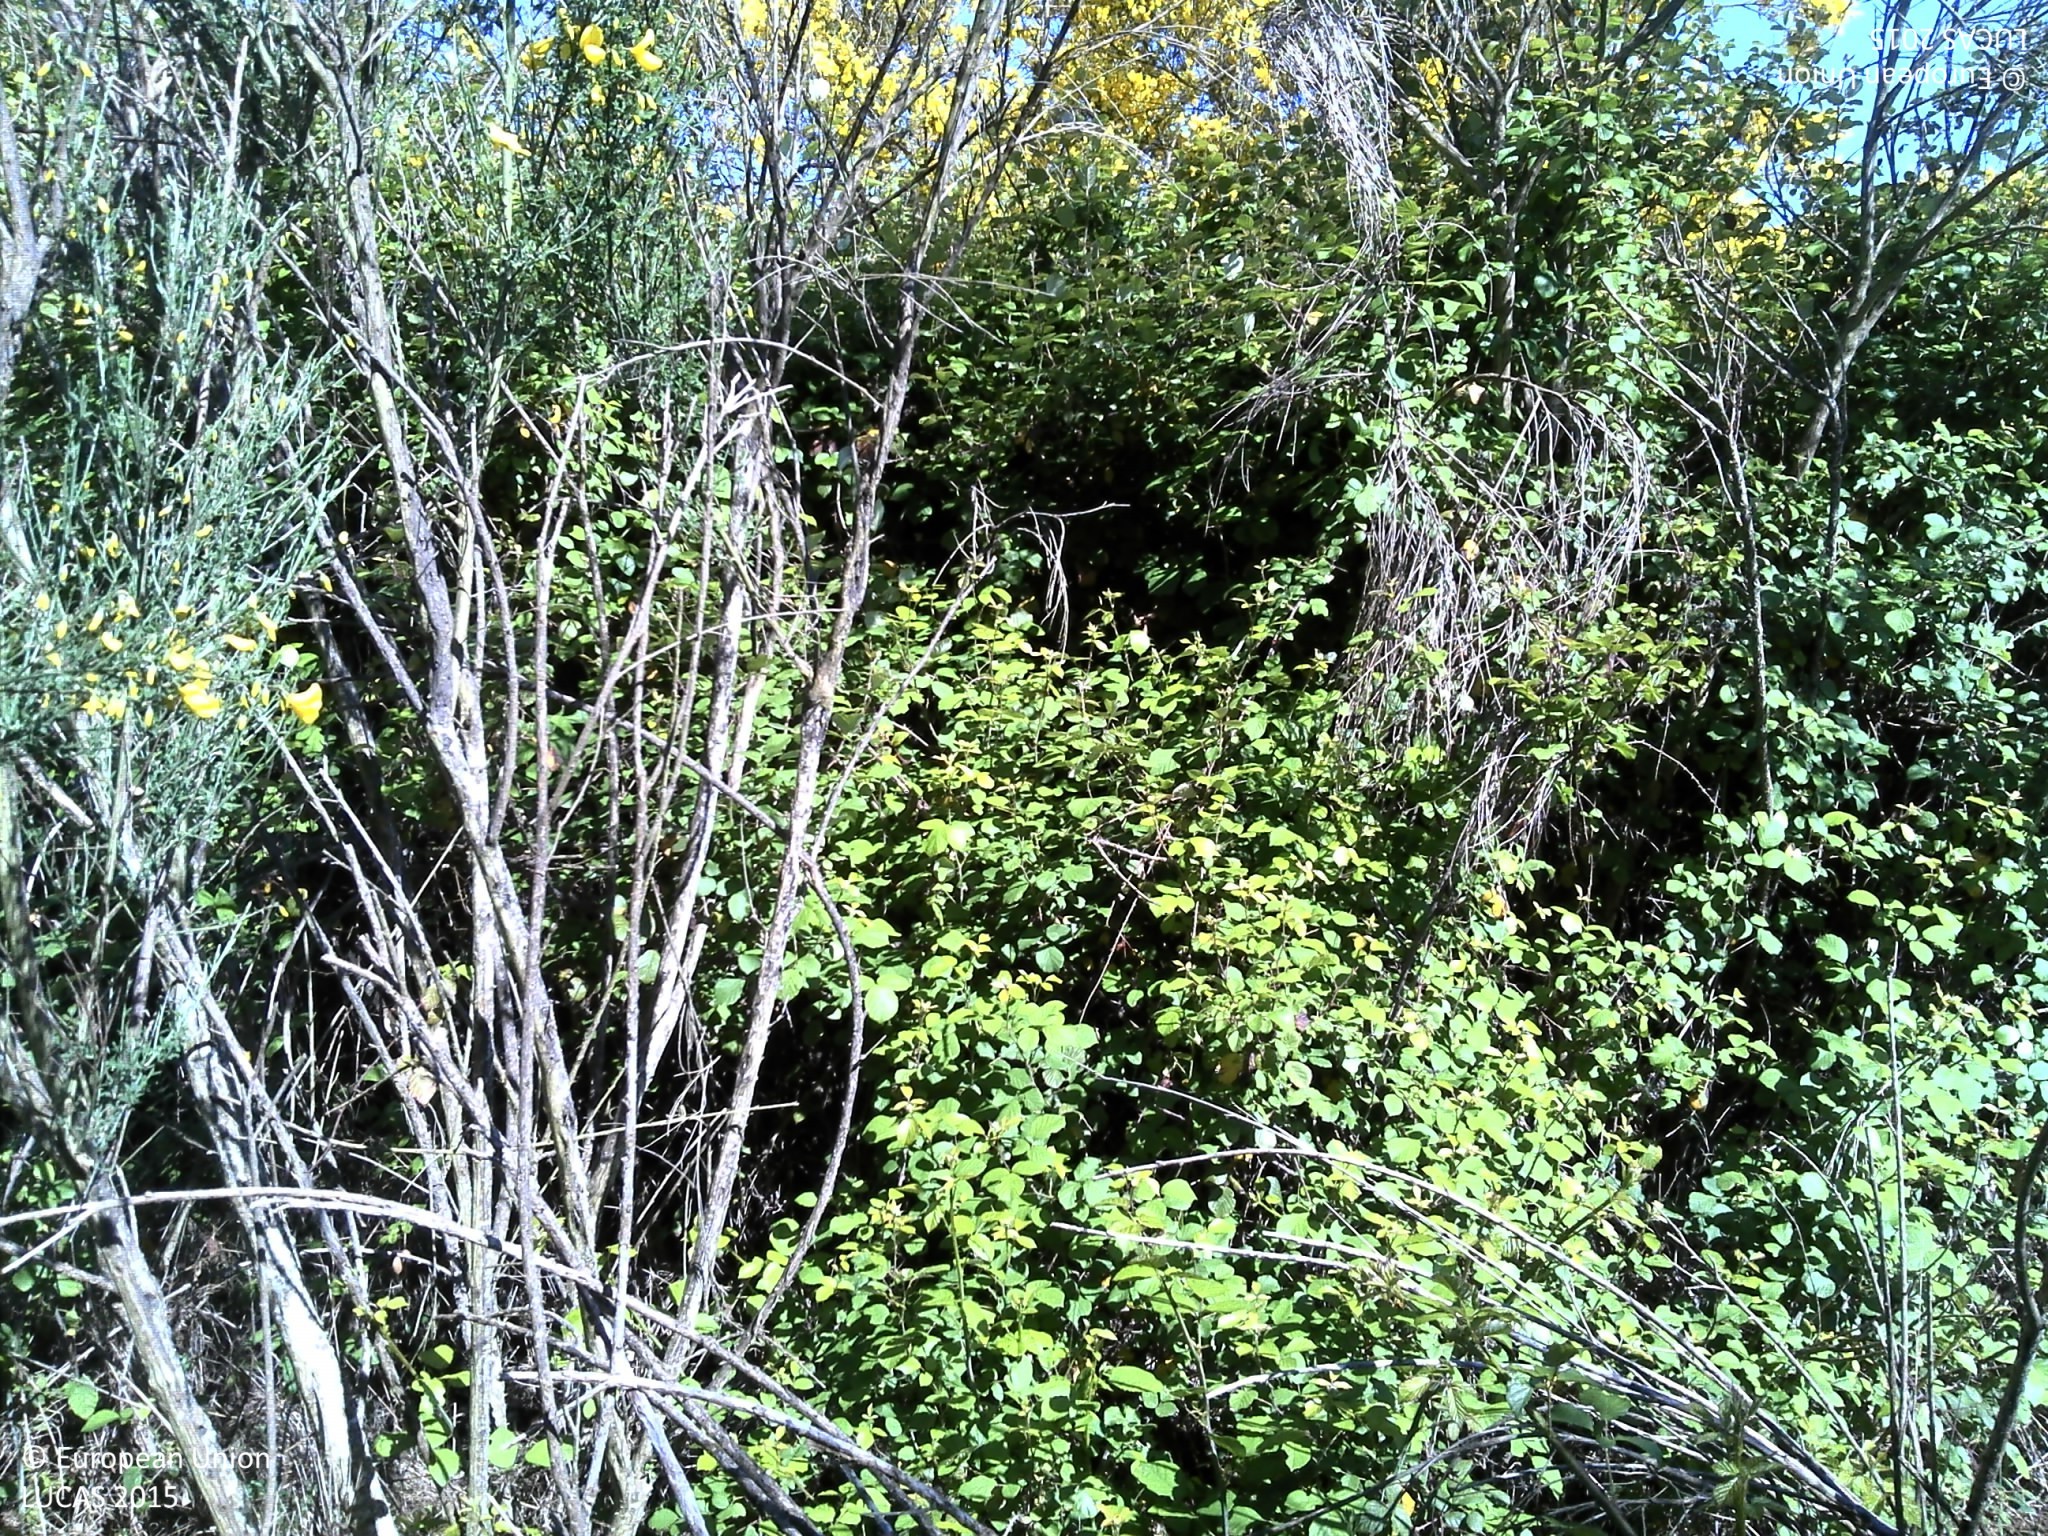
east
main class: Shrubland
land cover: Shrubland without tree cover
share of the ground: 50 - 75 %
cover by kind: shrubs 60 %, herbaceous plants 40 %
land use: Forestry
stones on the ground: < 10 %
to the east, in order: Shrubland without tree cover; Single bushes/trees; Maize; Grass margins; Dry stone walls; Vineyards; Dry stone walls; Grassland without tree/shrub cover; Shrubland with sparse tree cover; Shrubland without tree cover; Grass margins; Vineyards
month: May
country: PT
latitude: 41.8372
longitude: -7.3858
